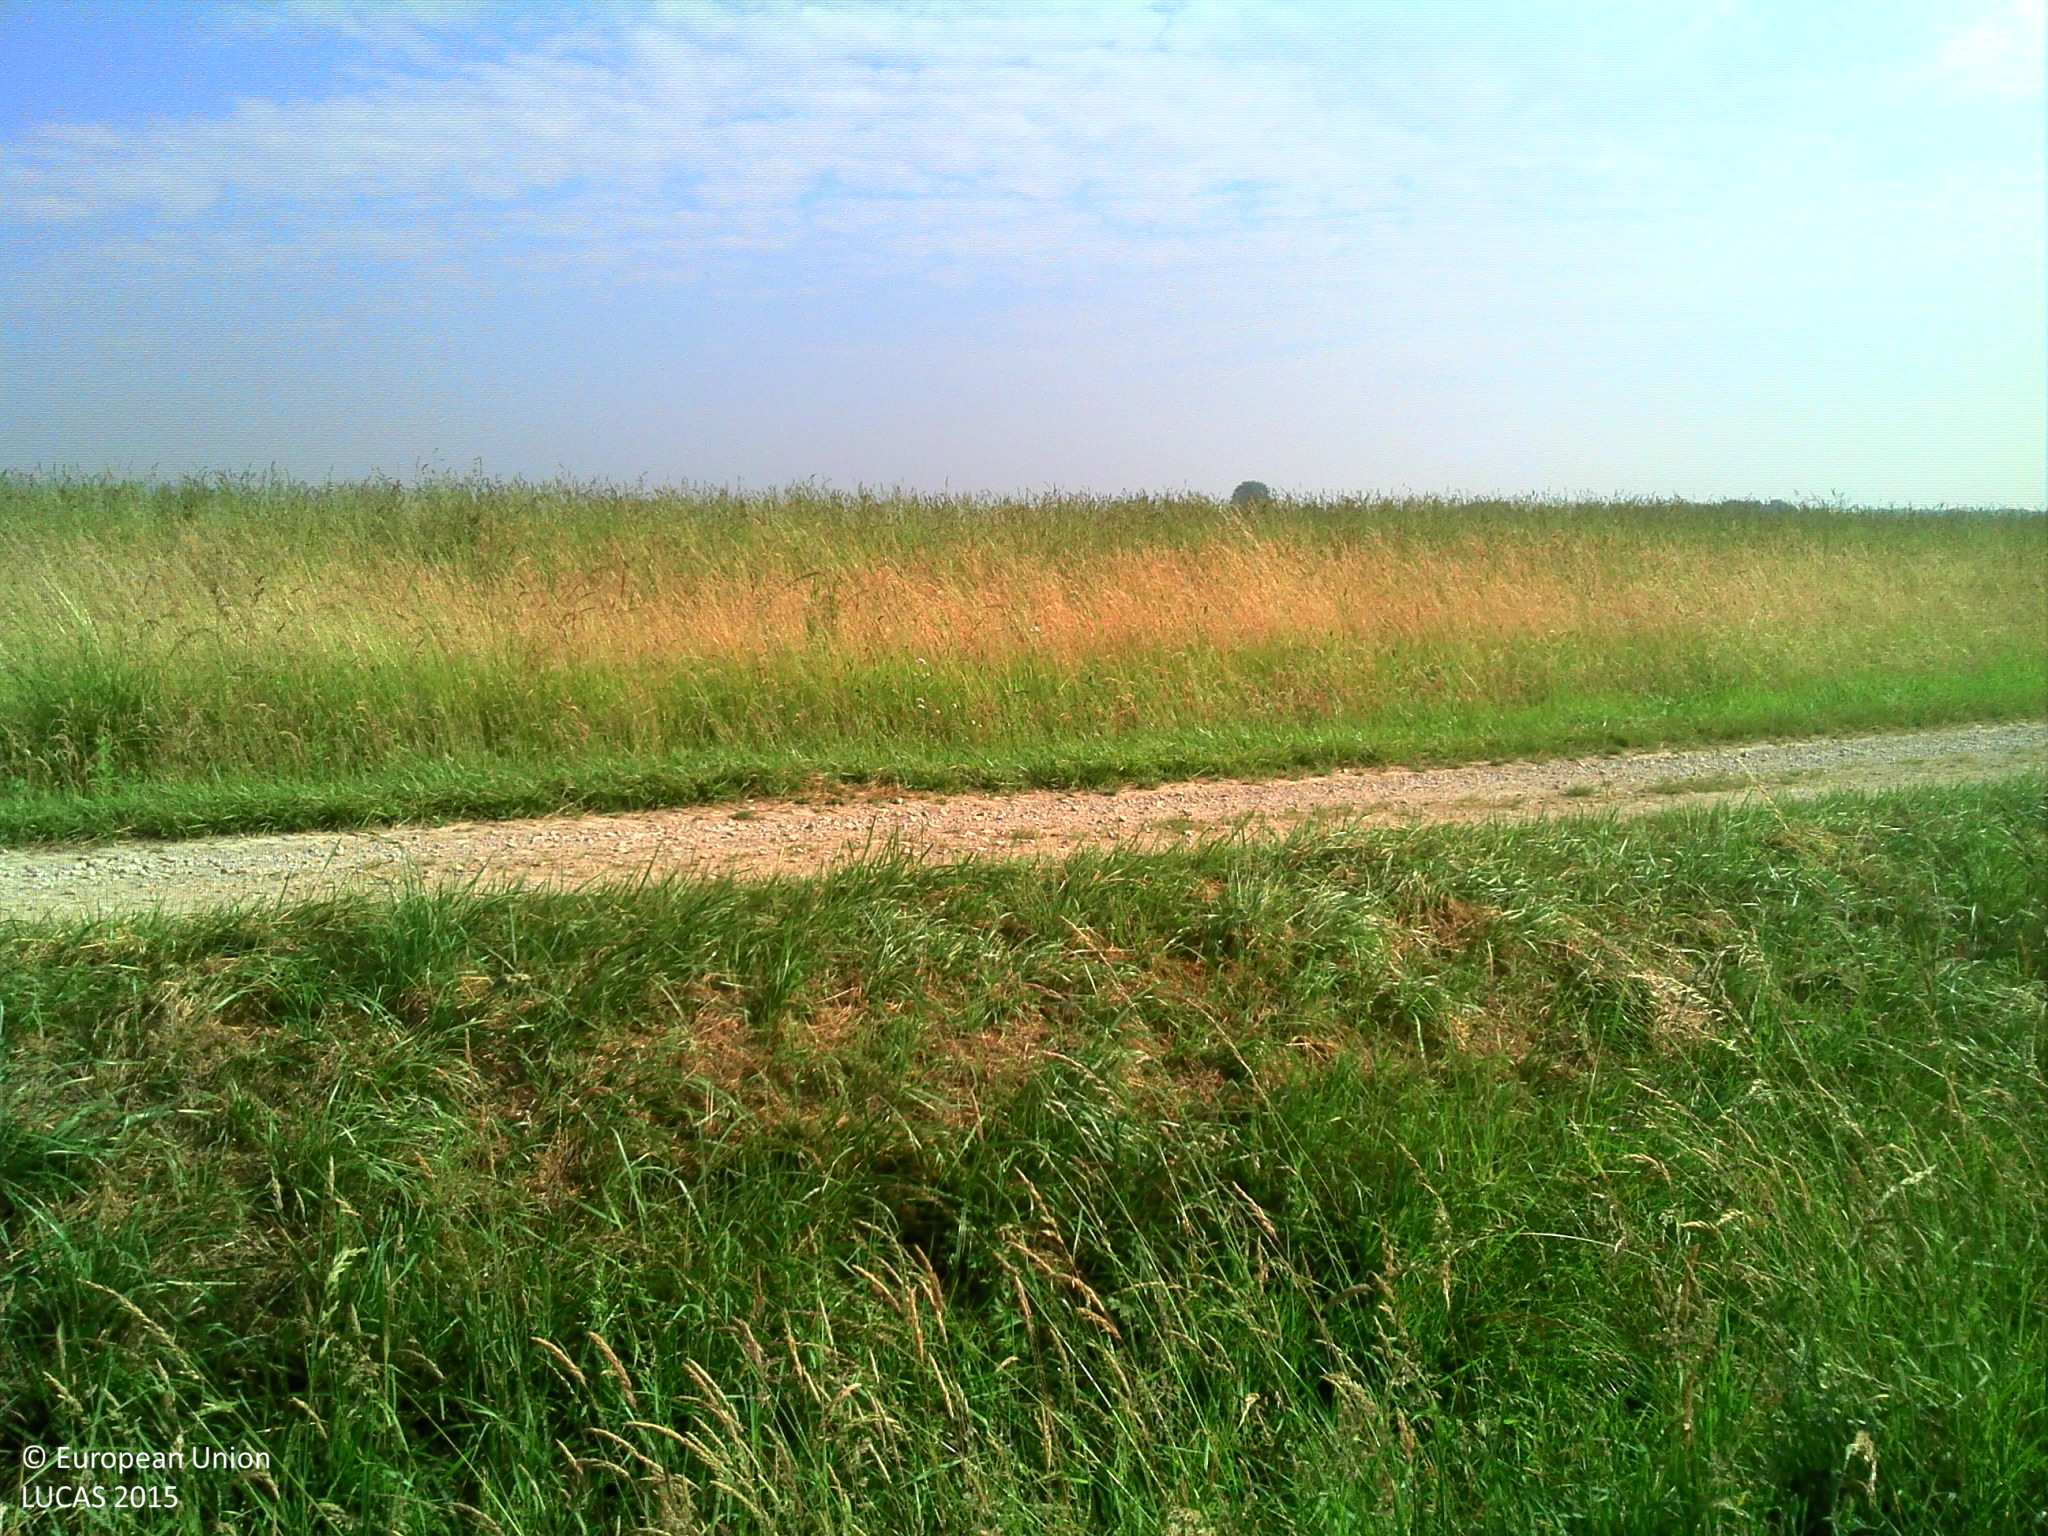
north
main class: Cropland
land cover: Temporary grasslands
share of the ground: > 75 %
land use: Agriculture (excluding fallow land and kitchen gardens)
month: June
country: FR
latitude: 47.5809
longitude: 7.4090
